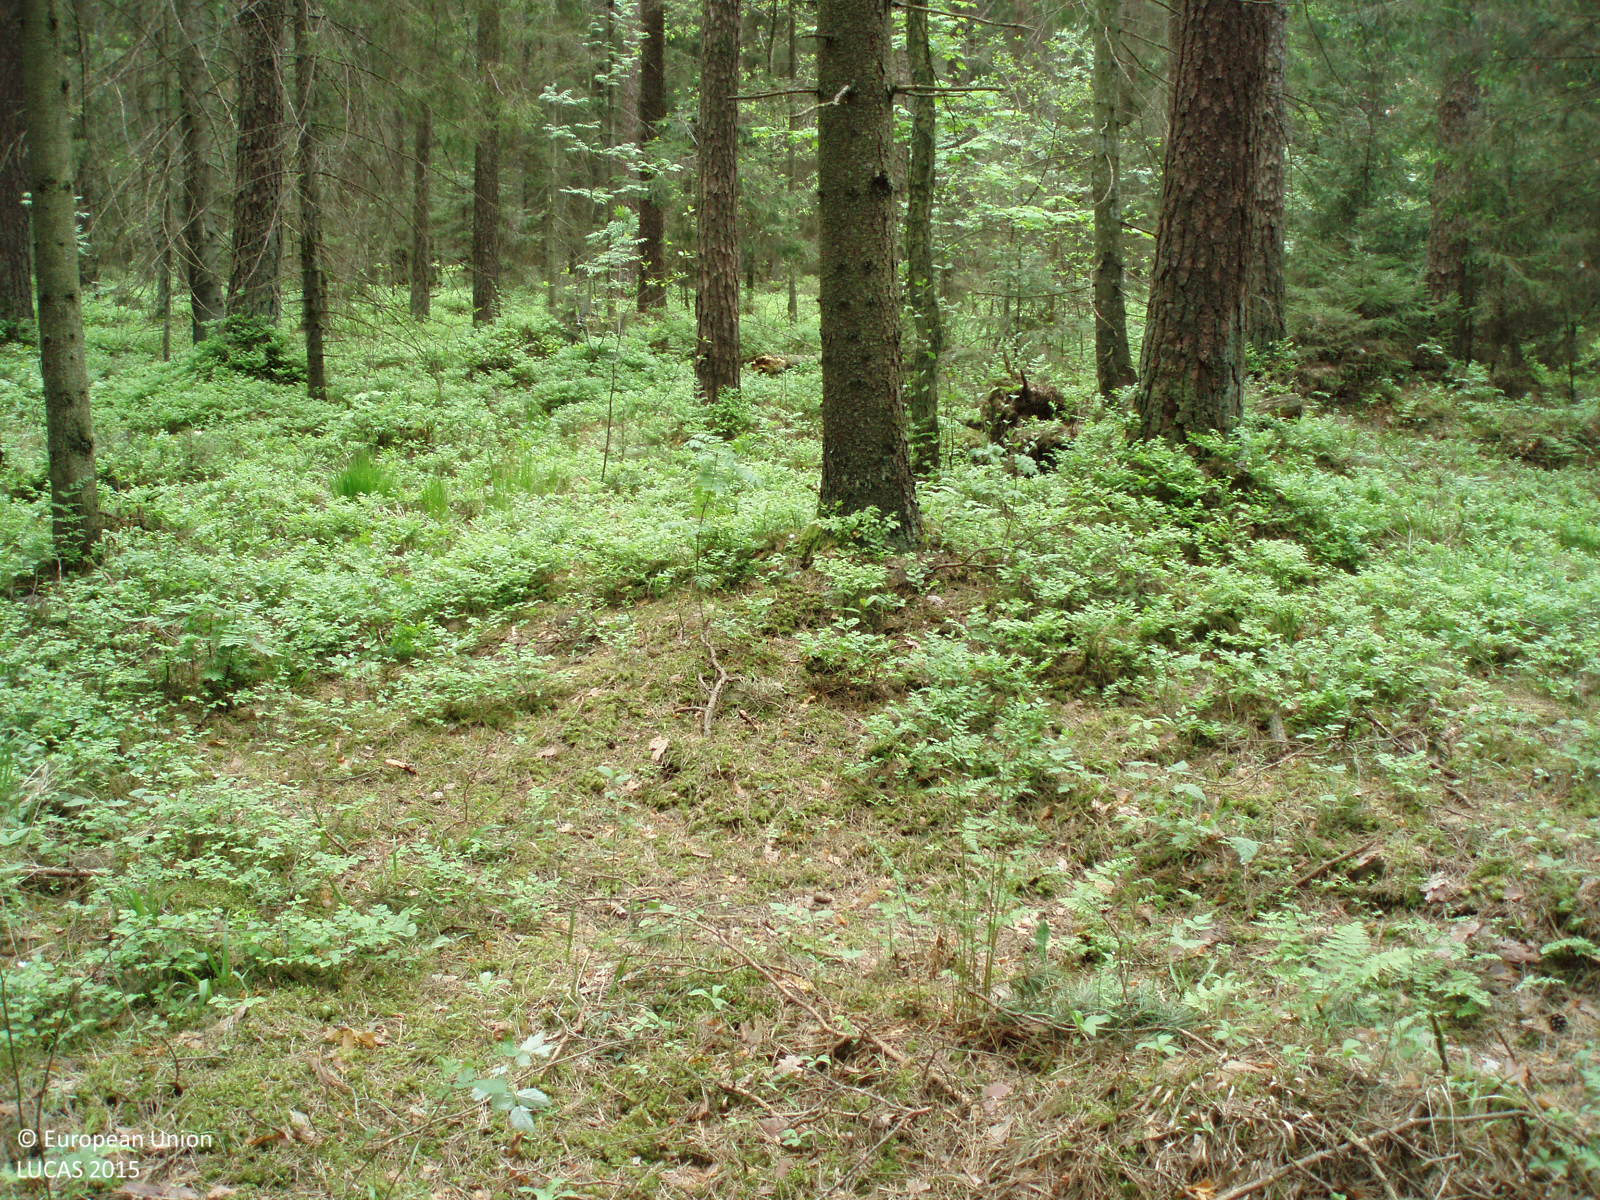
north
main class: Woodland
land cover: Pine dominated coniferous woodland
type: hemiboreal forest and nemoral coniferous forest and mixed broadleaved-coniferous forest
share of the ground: > 75 %
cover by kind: coniferous forest trees 95 %, herbaceous plants 5 %
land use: Forestry
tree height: > 5 m
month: May
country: LT
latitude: 56.2092
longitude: 22.5211
